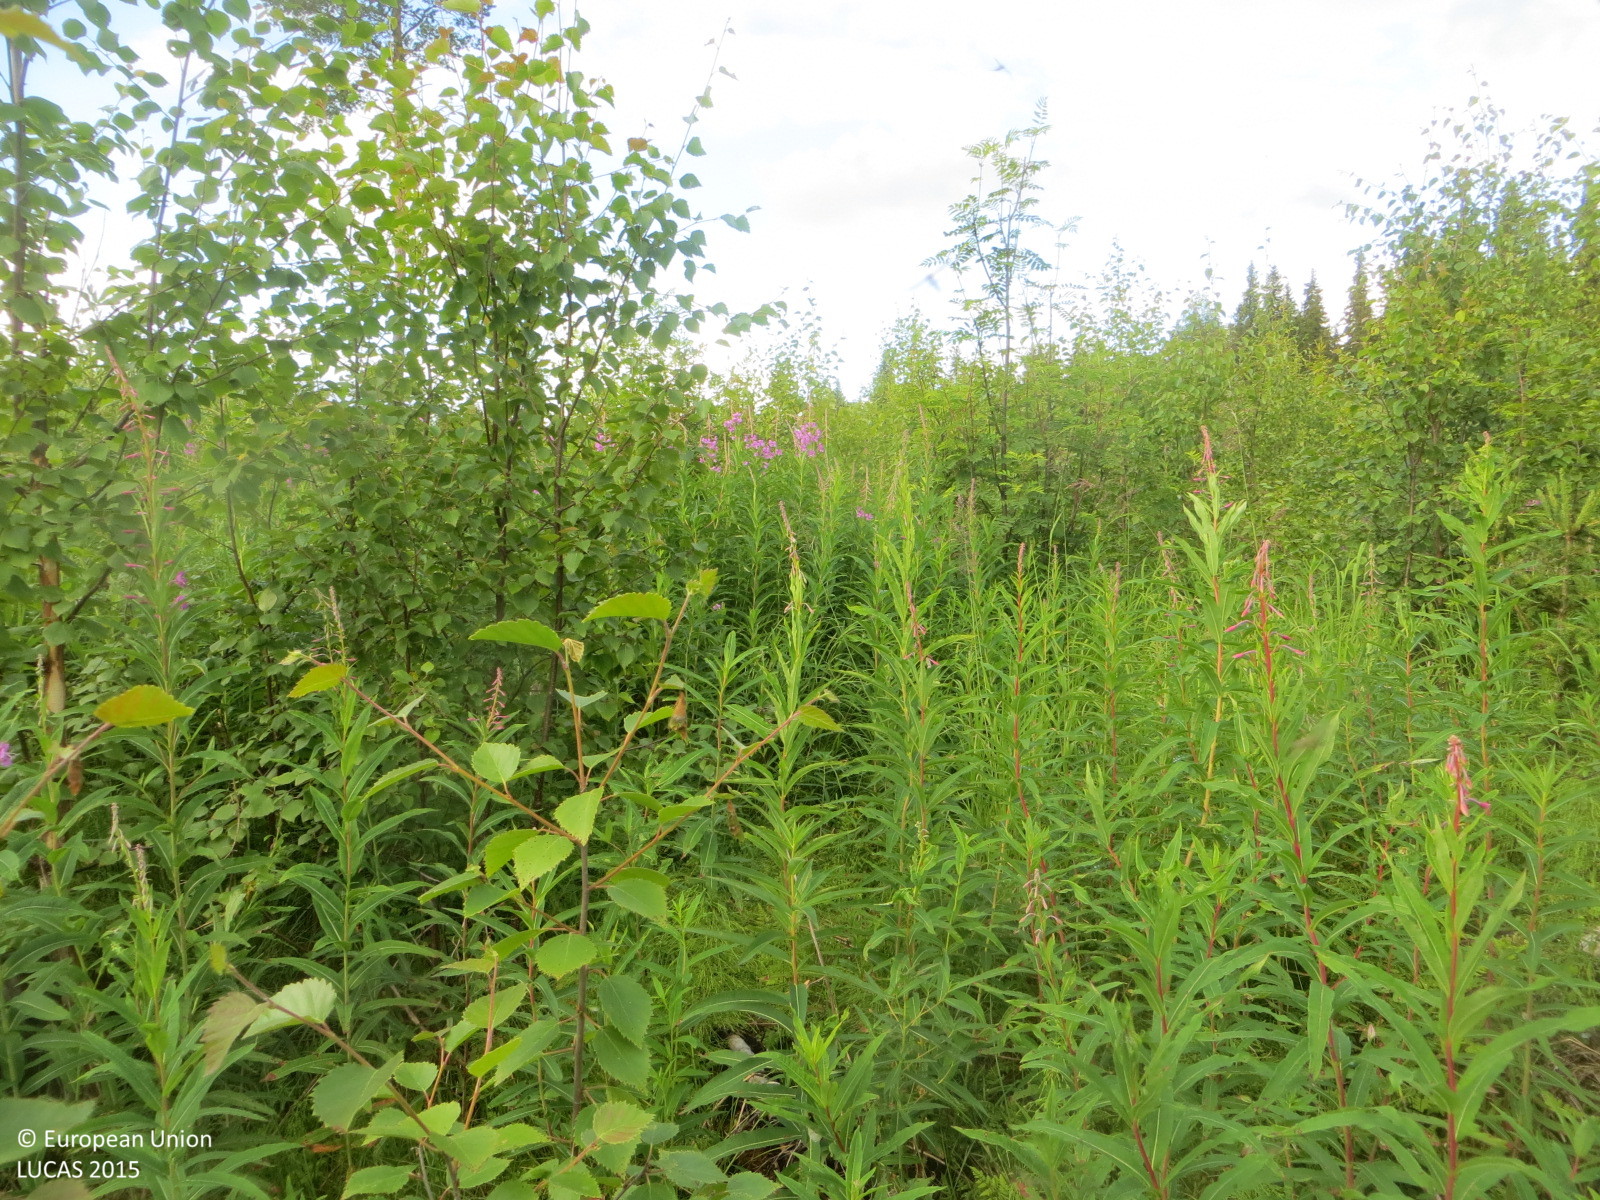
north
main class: Woodland
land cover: Broadleaved woodland
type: boreal forest
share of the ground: > 75 %
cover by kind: broadleaved forest trees 75 %, herbaceous plants 15 %, shrubs 10 %
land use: Forestry
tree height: < 5 m
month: July
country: FI
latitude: 65.9955
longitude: 24.3008
